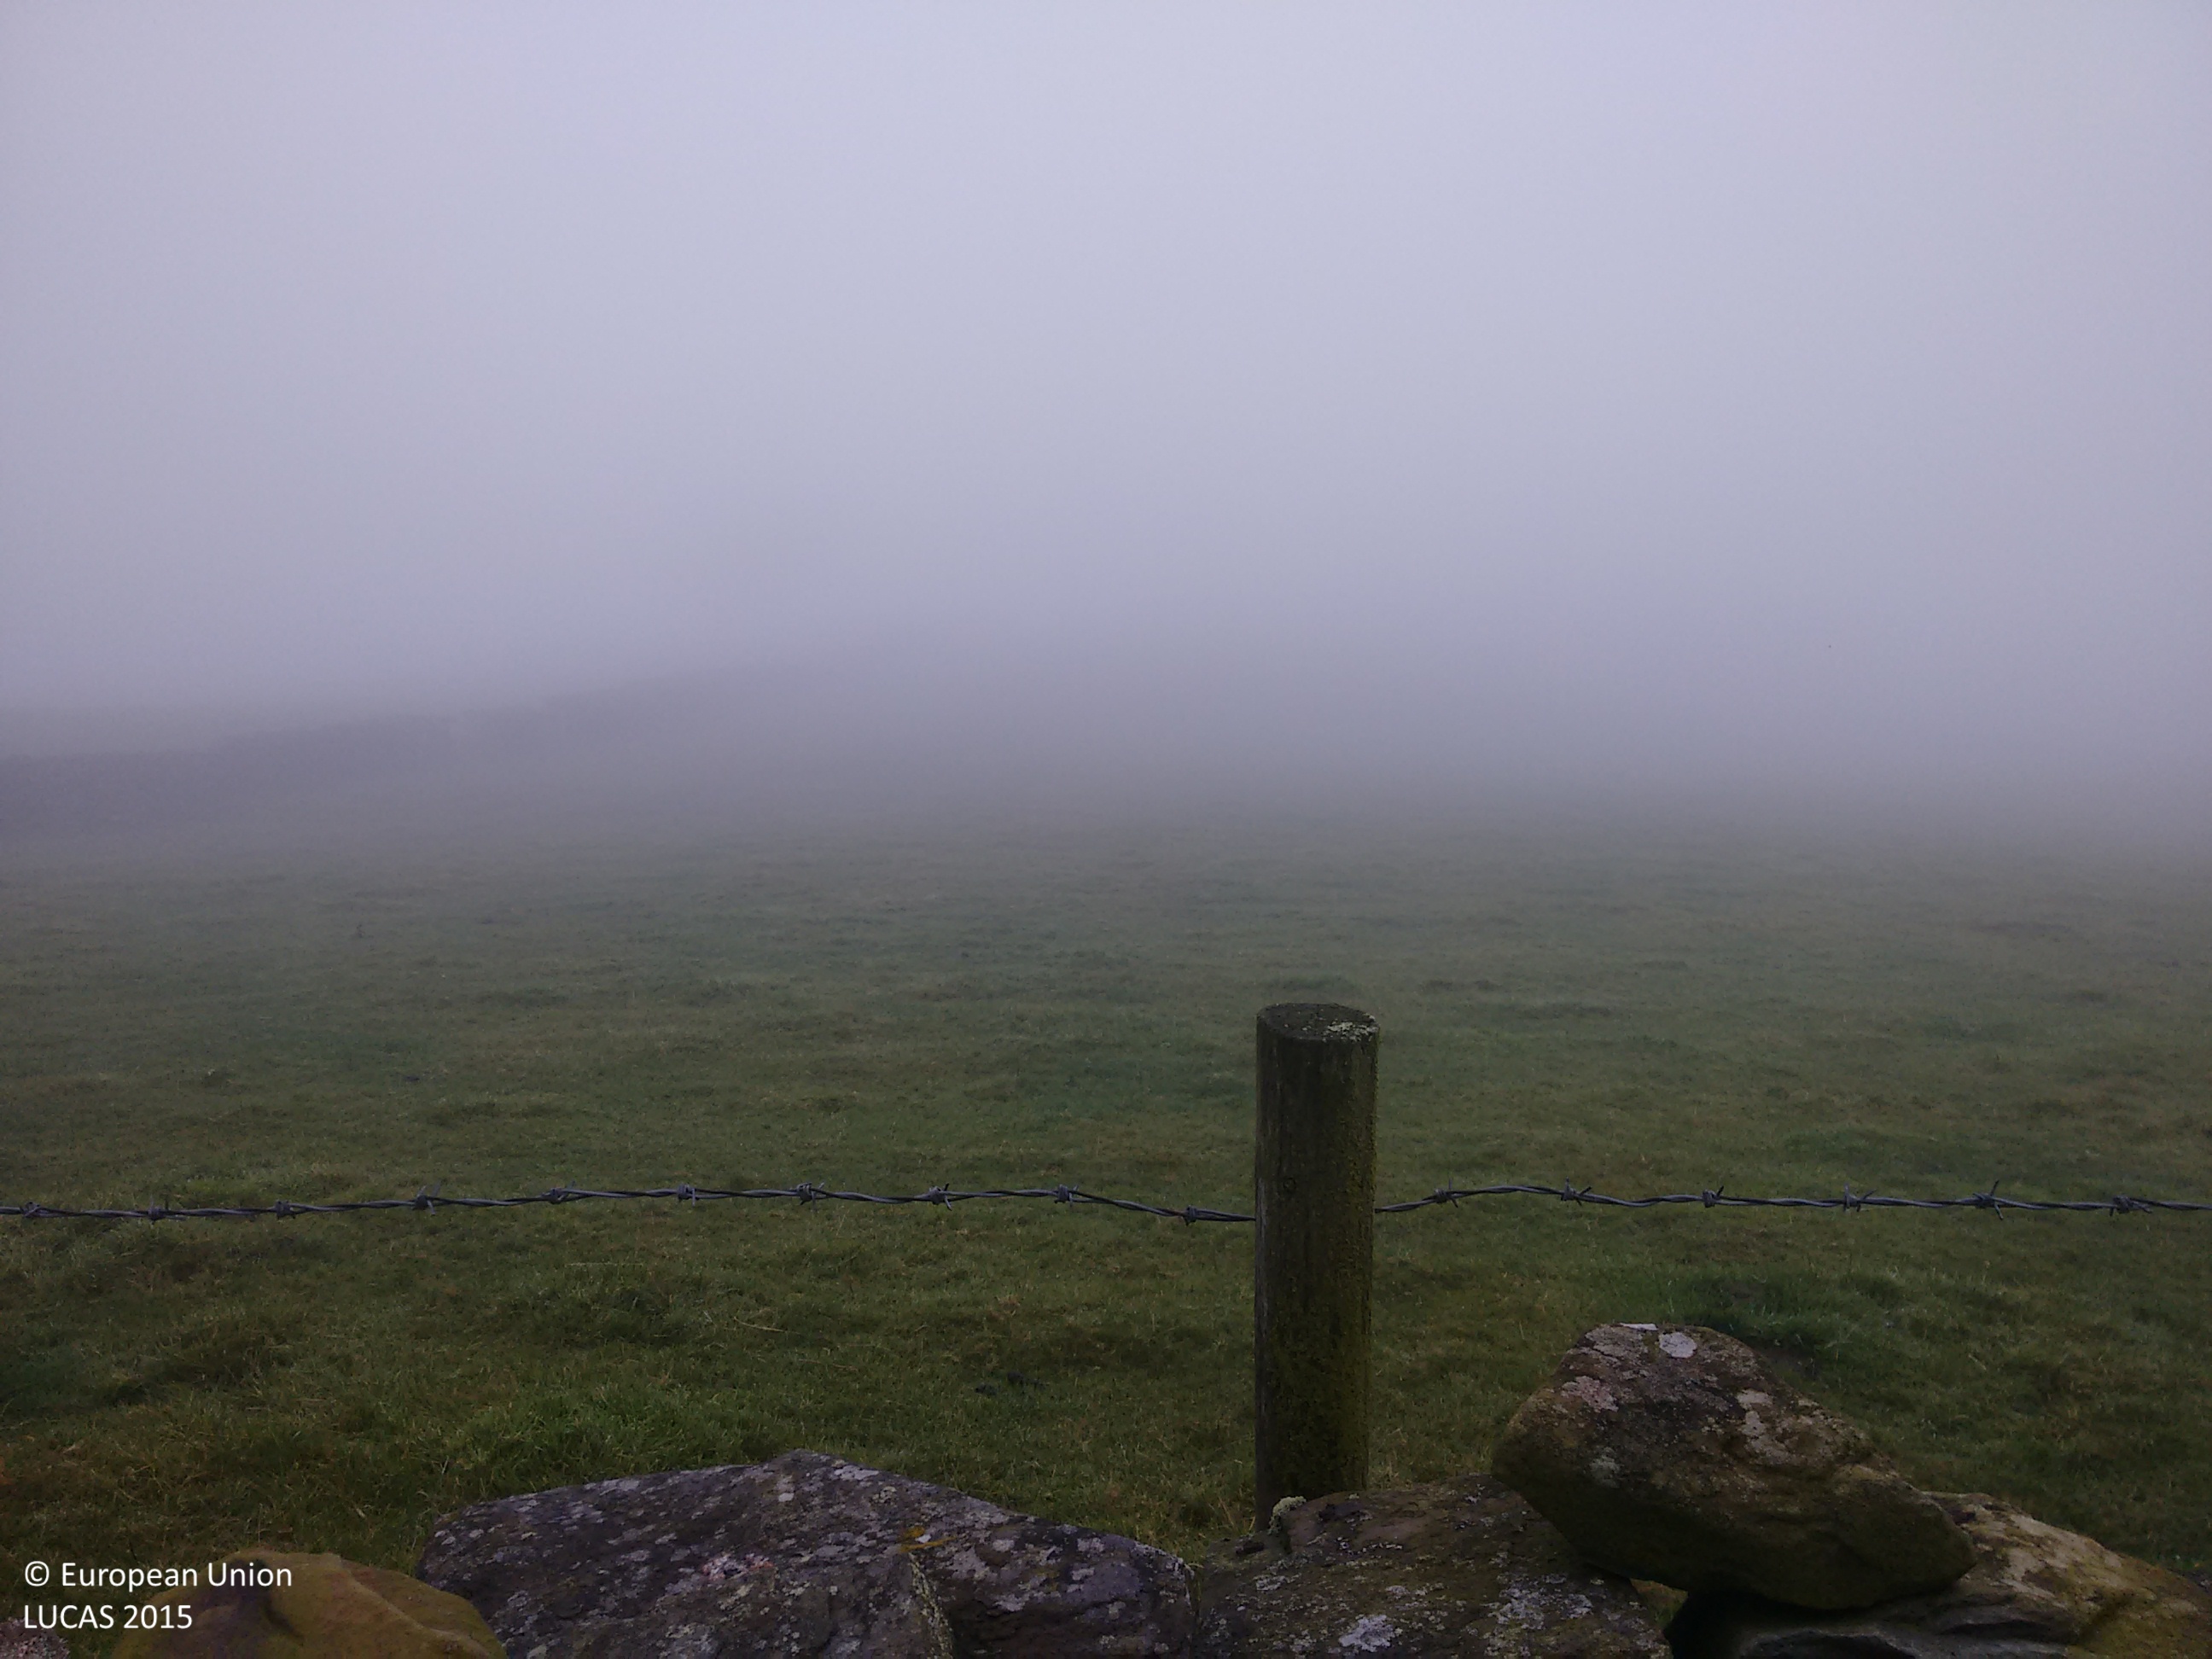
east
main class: Grassland
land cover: Grassland without tree/shrub cover
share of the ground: > 75 %
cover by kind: herbaceous plants 100 %
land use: Agriculture (excluding fallow land and kitchen gardens)
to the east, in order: Dry stone walls; Fences; Grassland without tree/shrub cover; Dry stone walls; Grassland without tree/shrub cover; Dry stone walls; Grassland without tree/shrub cover; Single bushes/trees; Grassland without tree/shrub cover; Single bushes/trees; Grassland without tree/shrub cover; Single bushes/trees; Grassland without tree/shrub cover
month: November
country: GB
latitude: 54.2357
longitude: -3.1006
